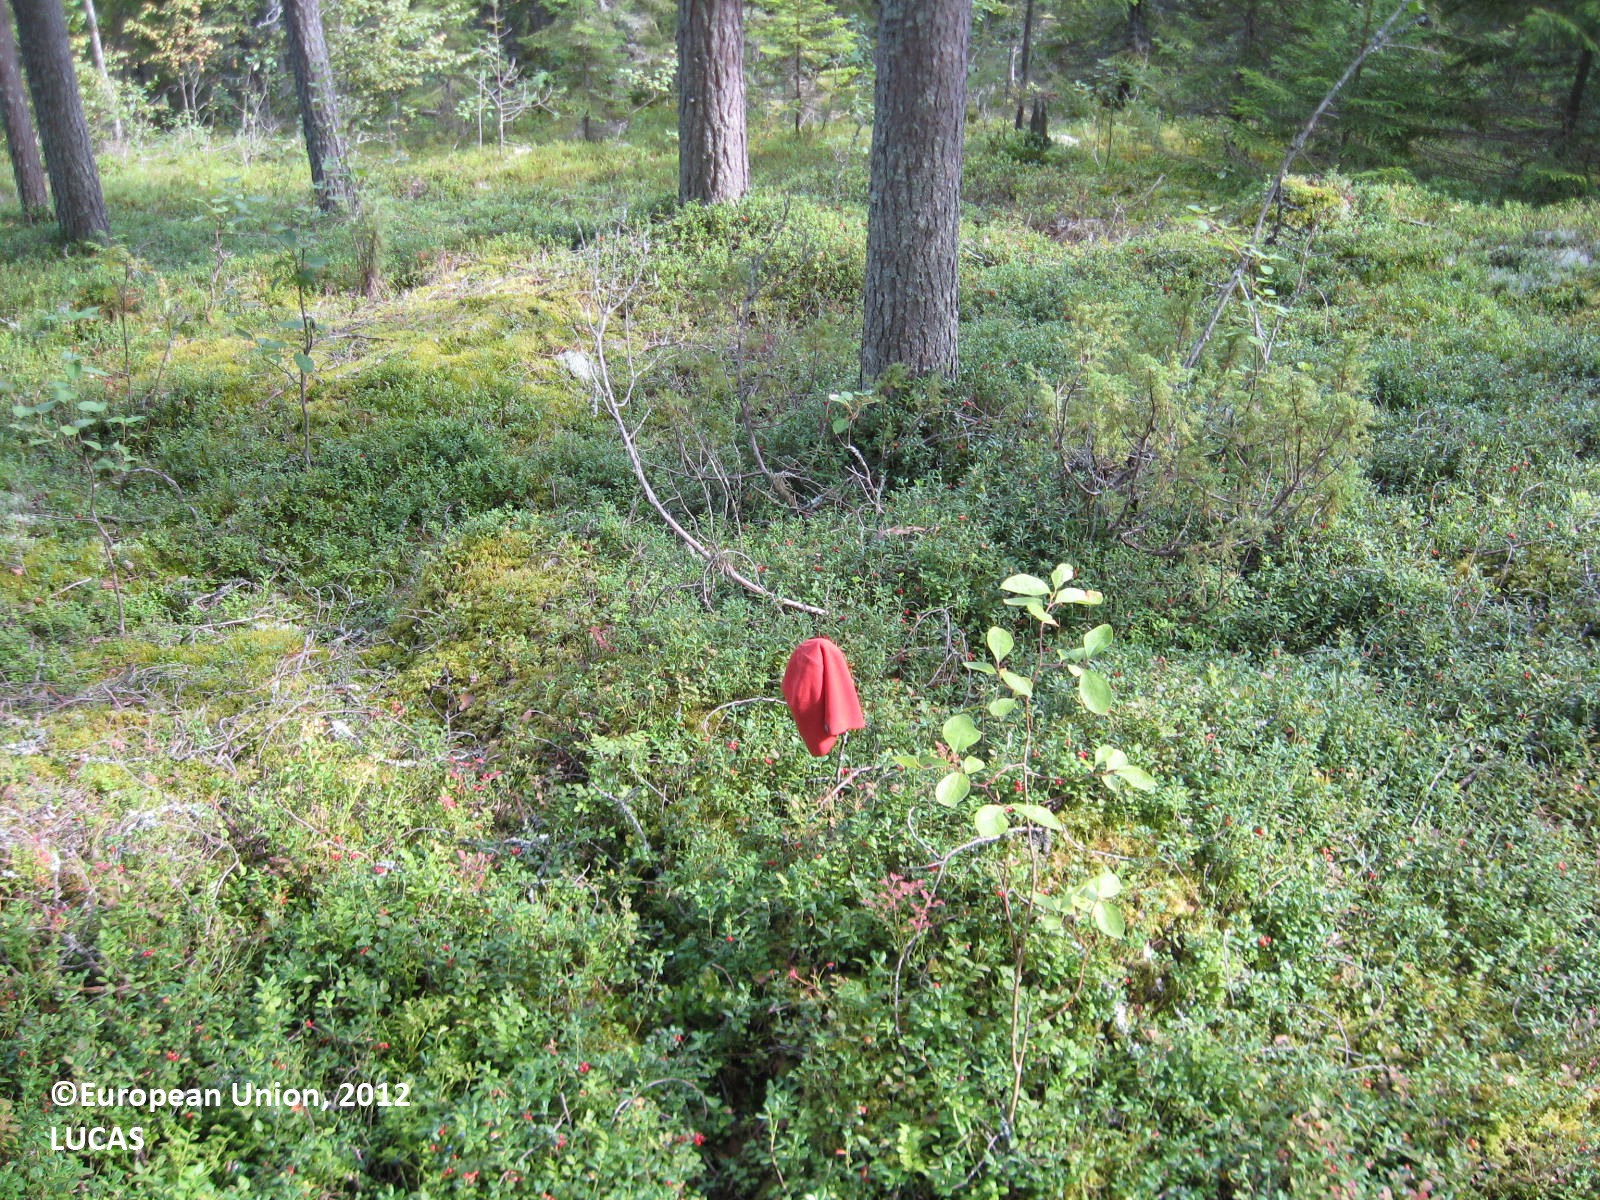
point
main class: Woodland
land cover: Pine dominated coniferous woodland
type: boreal forest
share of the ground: < 10 %
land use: Forestry
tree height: > 5 m
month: August
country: FI
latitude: 63.5073
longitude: 30.3352
